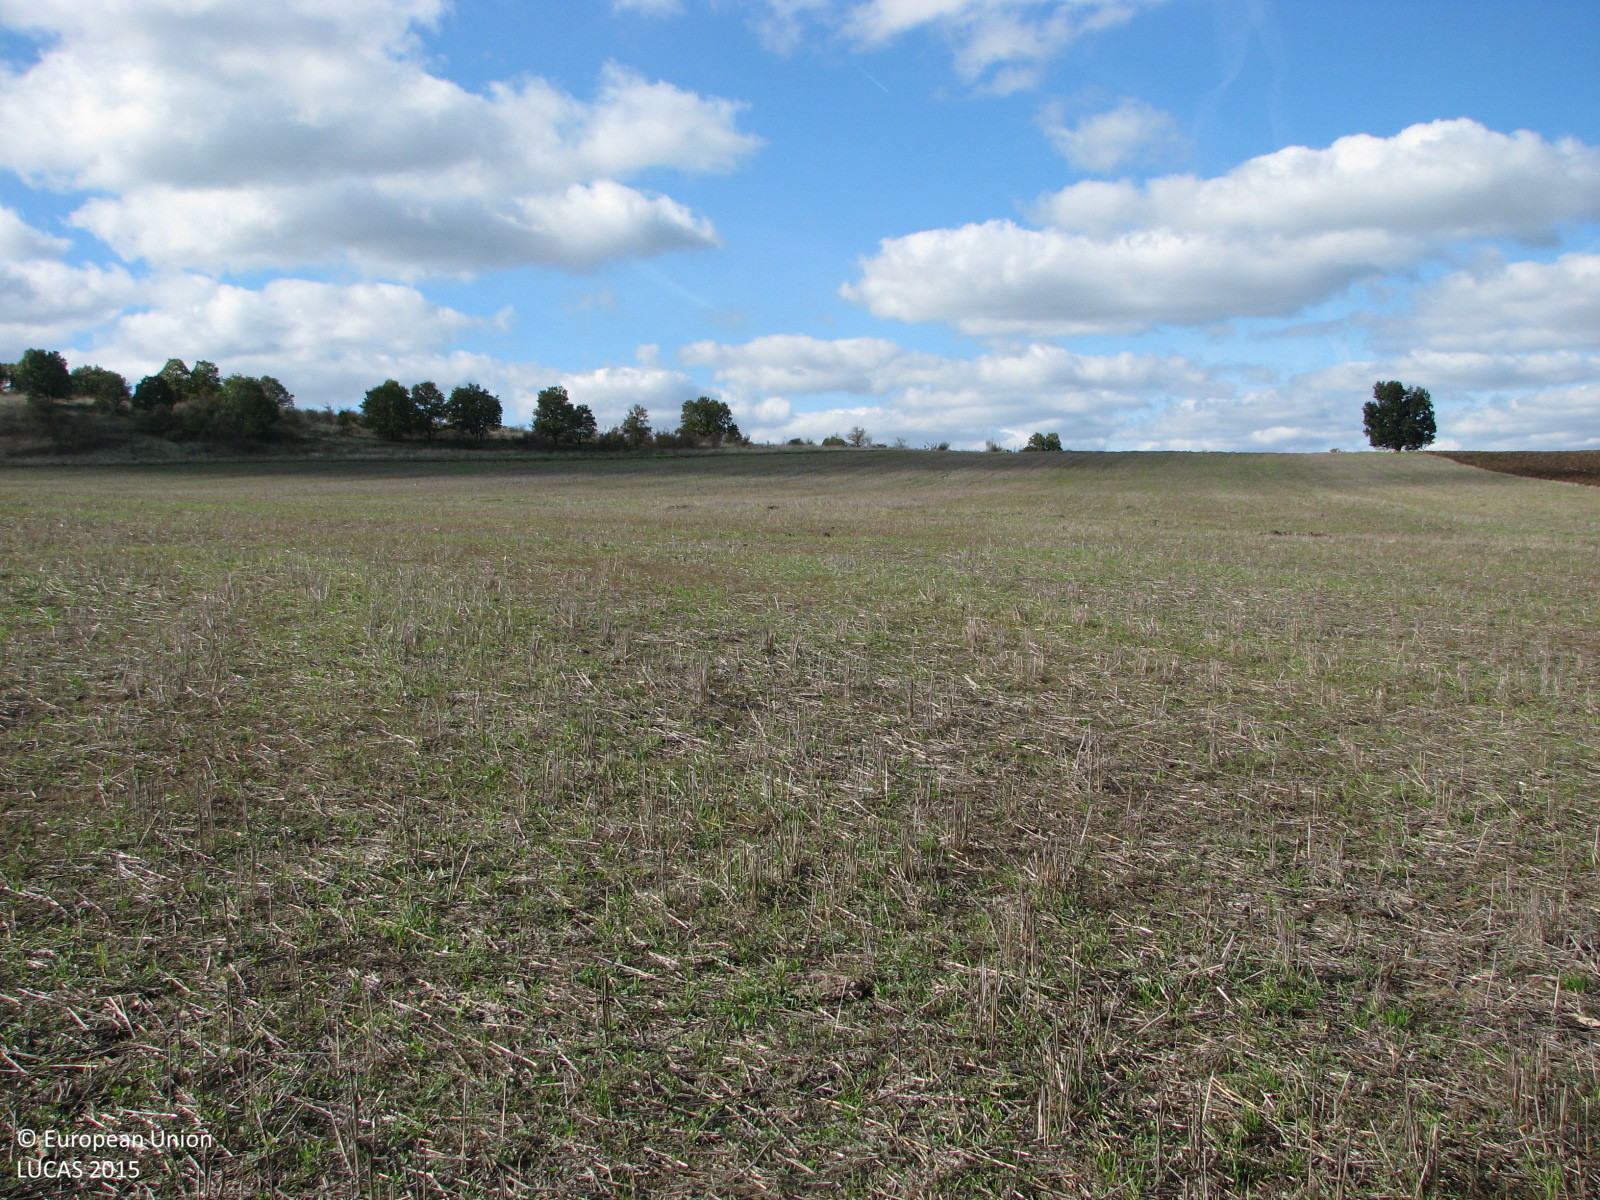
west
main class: Cropland
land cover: Common wheat
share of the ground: 25 - 50 %
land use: Agriculture (excluding fallow land and kitchen gardens)
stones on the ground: < 10 %
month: October
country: BG
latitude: 42.3062
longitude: 26.8016
